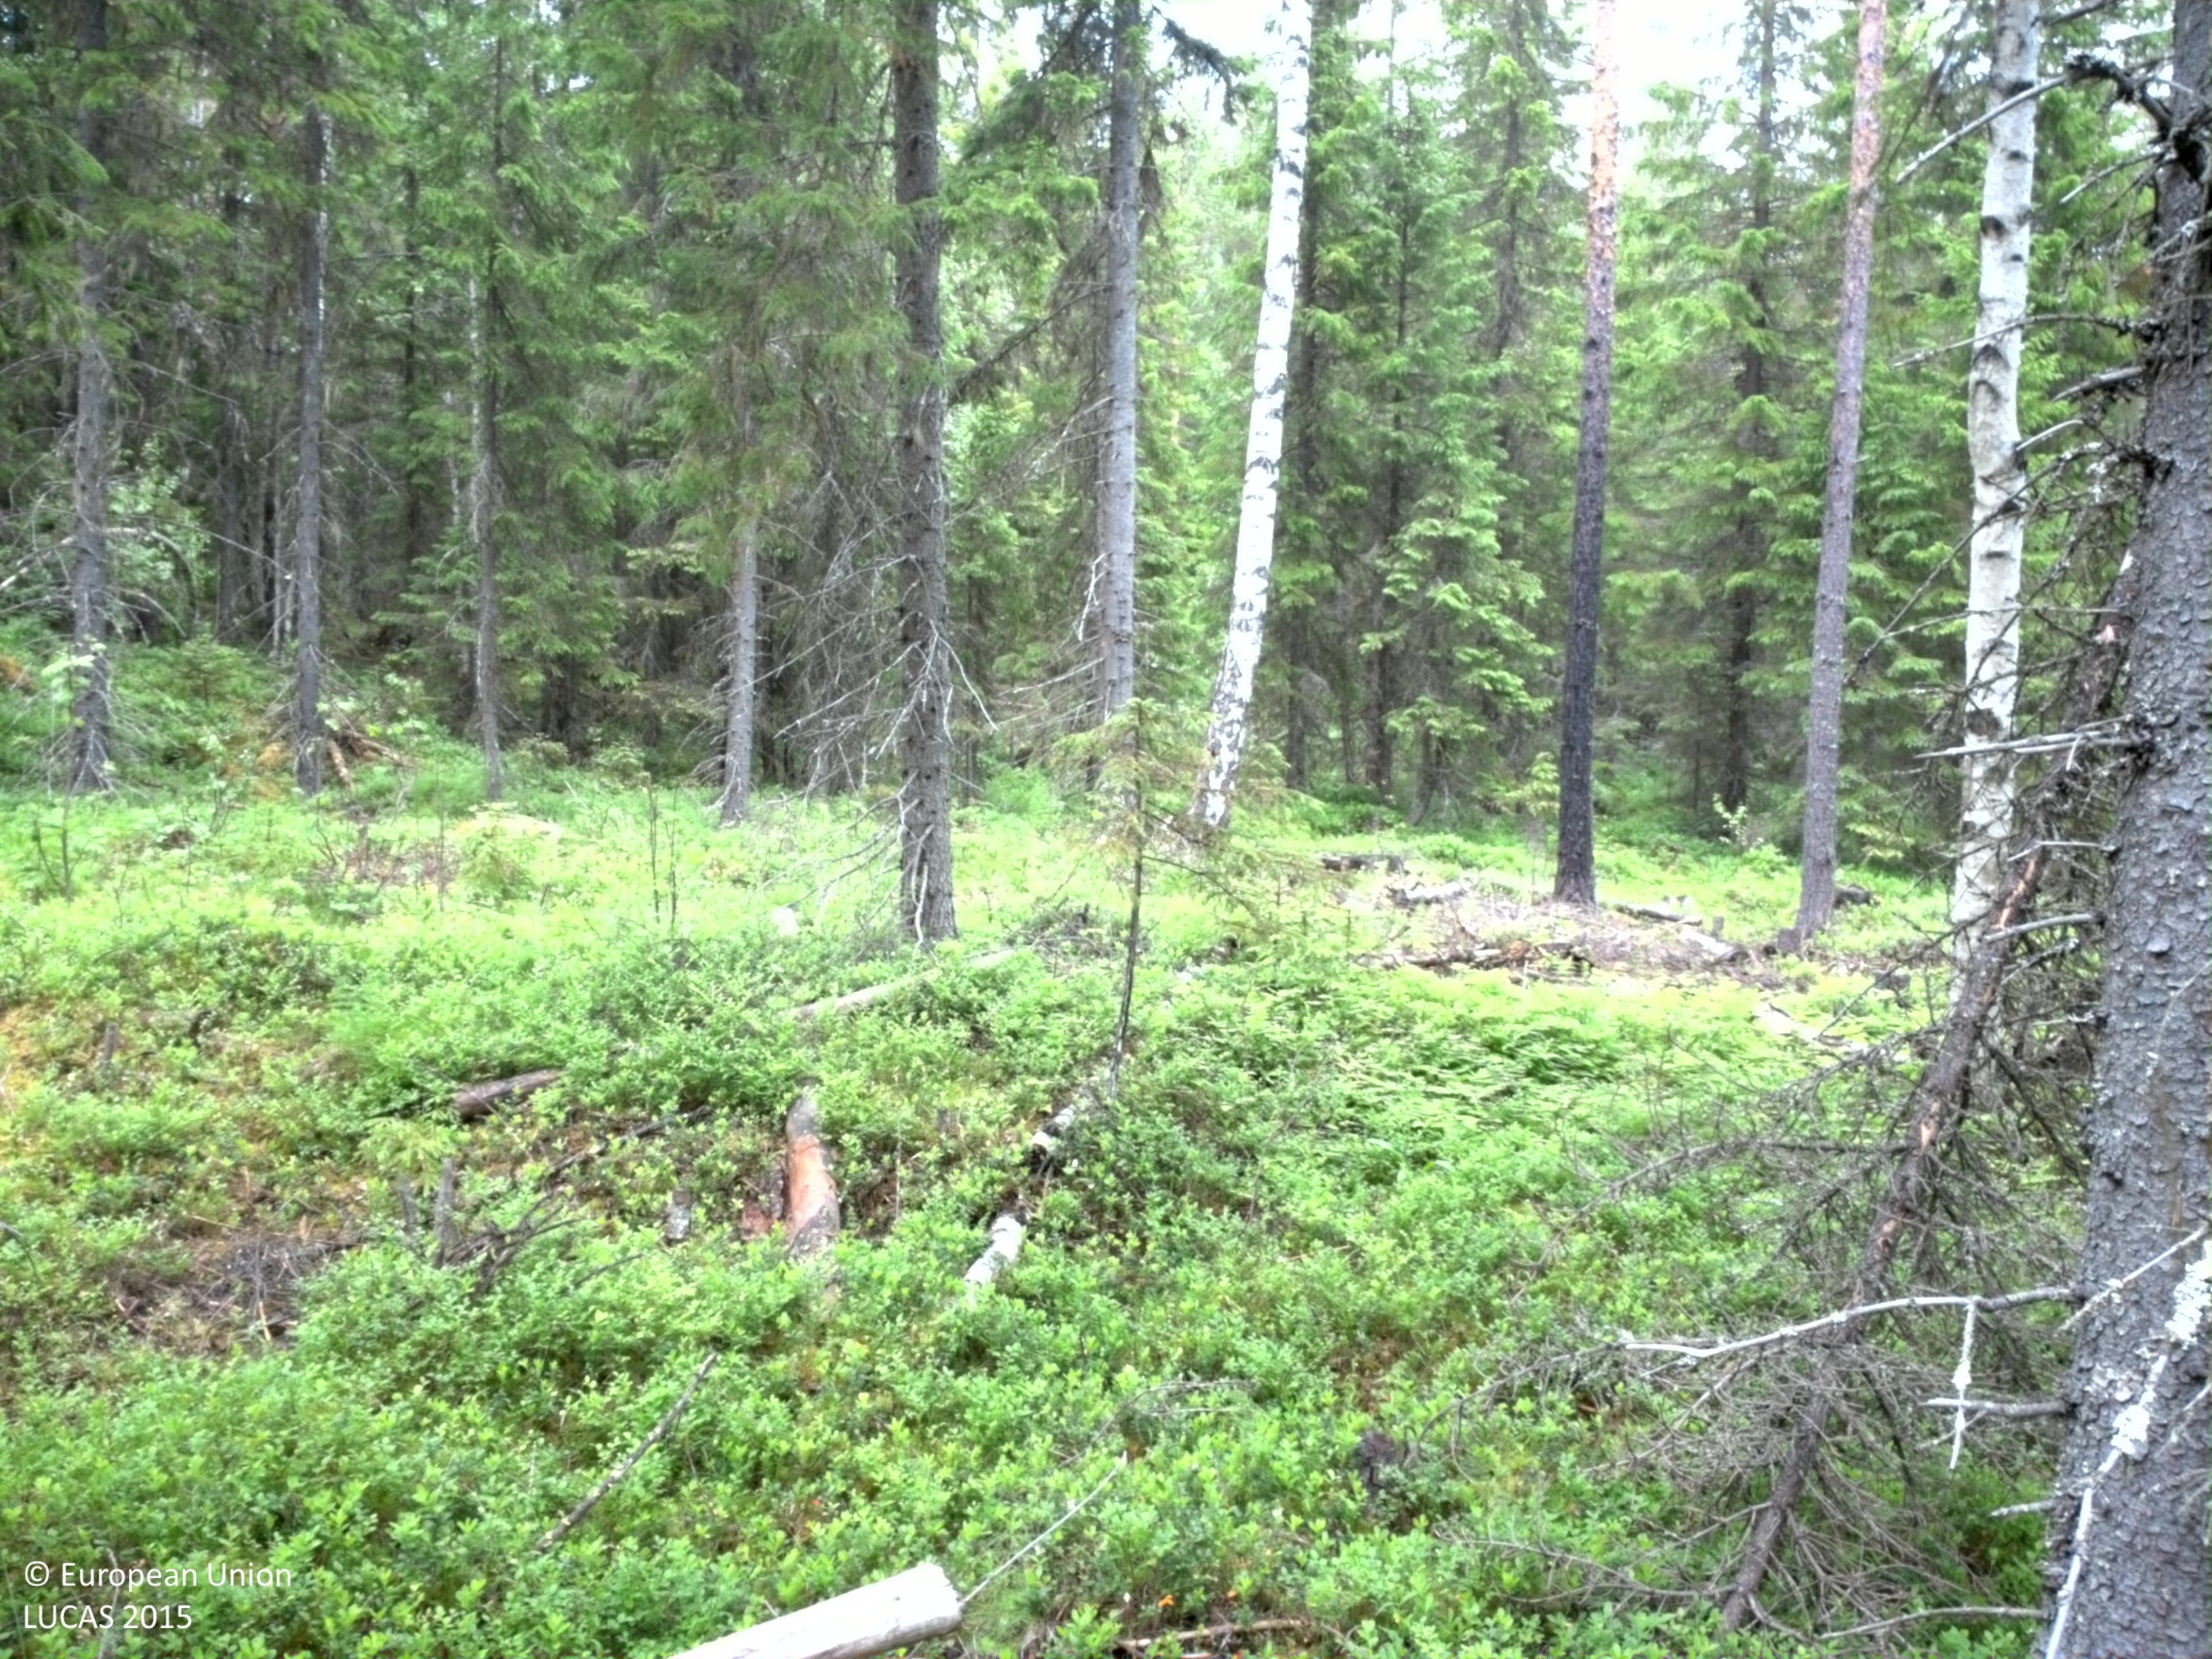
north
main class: Woodland
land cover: Spruce dominated coniferous woodland
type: boreal forest
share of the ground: 50 - 75 %
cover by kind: coniferous forest trees 45 %, shrubs 35 %, broadleaved forest trees 15 %, herbaceous plants 5 %
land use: Forestry
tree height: > 5 m
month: July
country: SE
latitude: 64.5346
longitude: 20.8814
